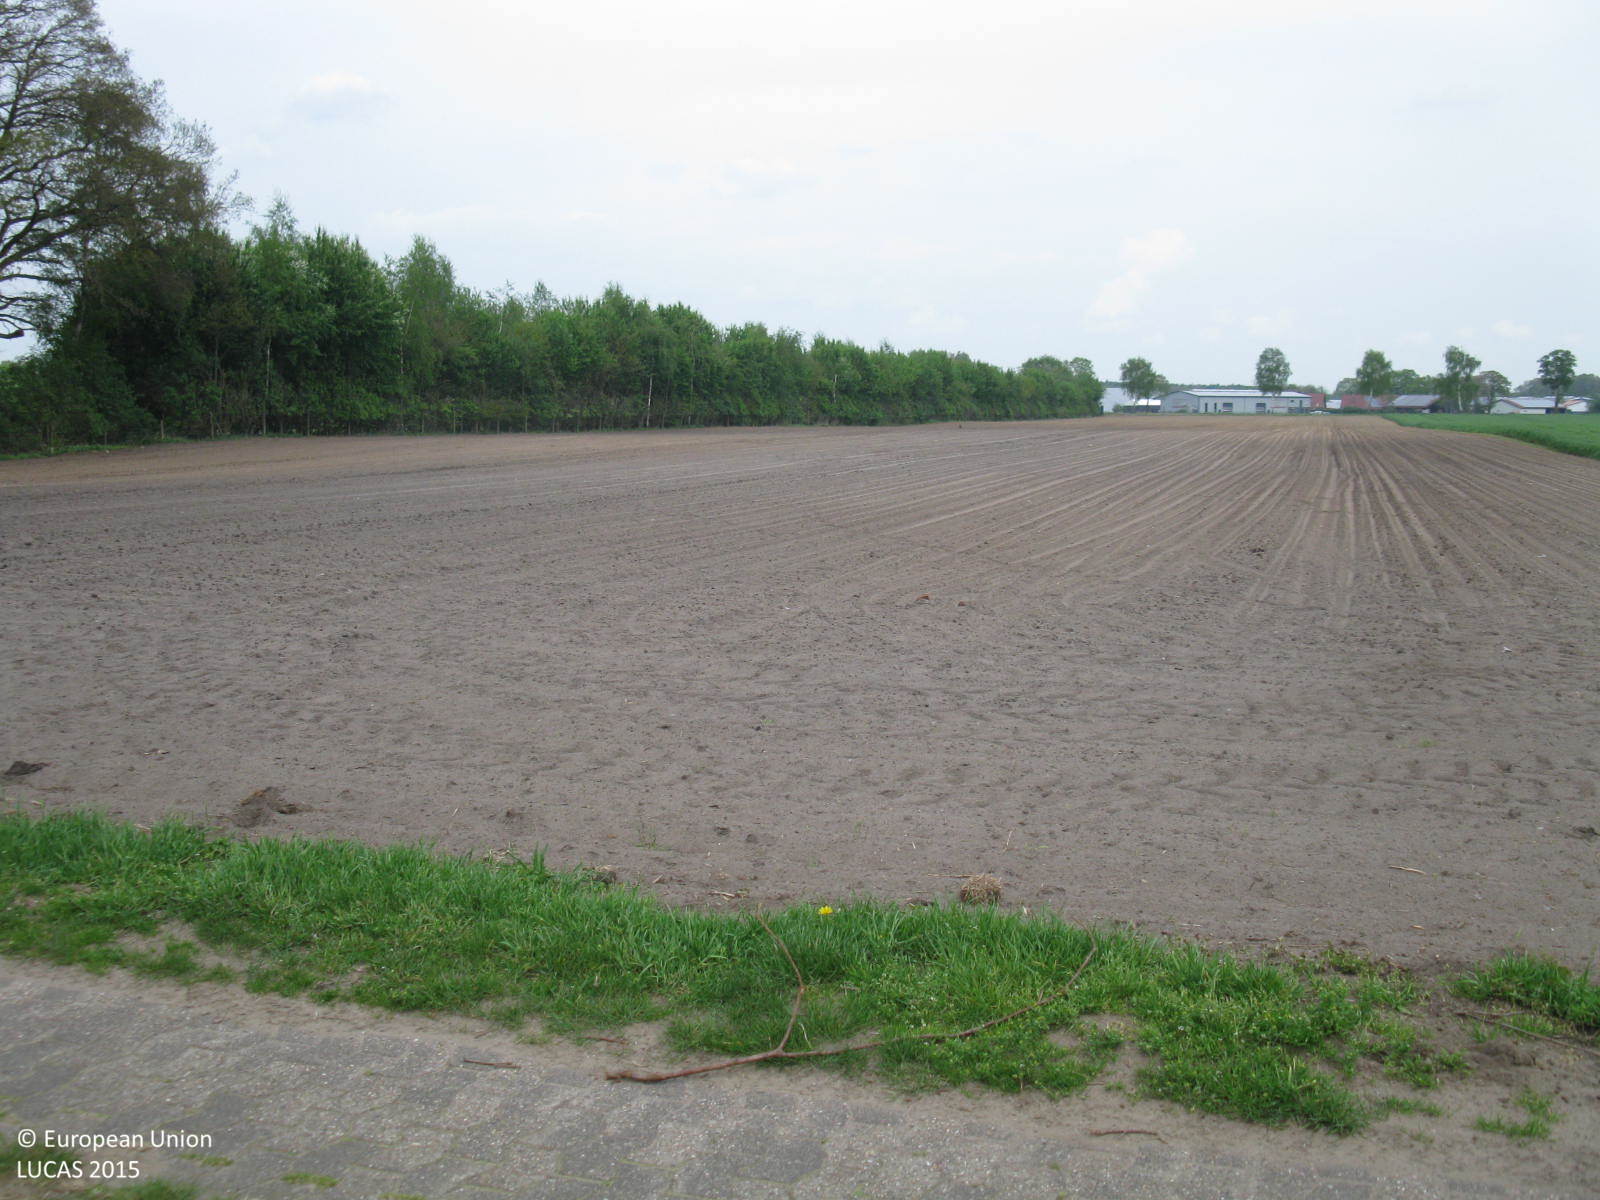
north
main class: Cropland
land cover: Rye
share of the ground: > 75 %
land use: Agriculture (excluding fallow land and kitchen gardens)
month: May
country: DE
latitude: 52.8450
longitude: 7.9368
